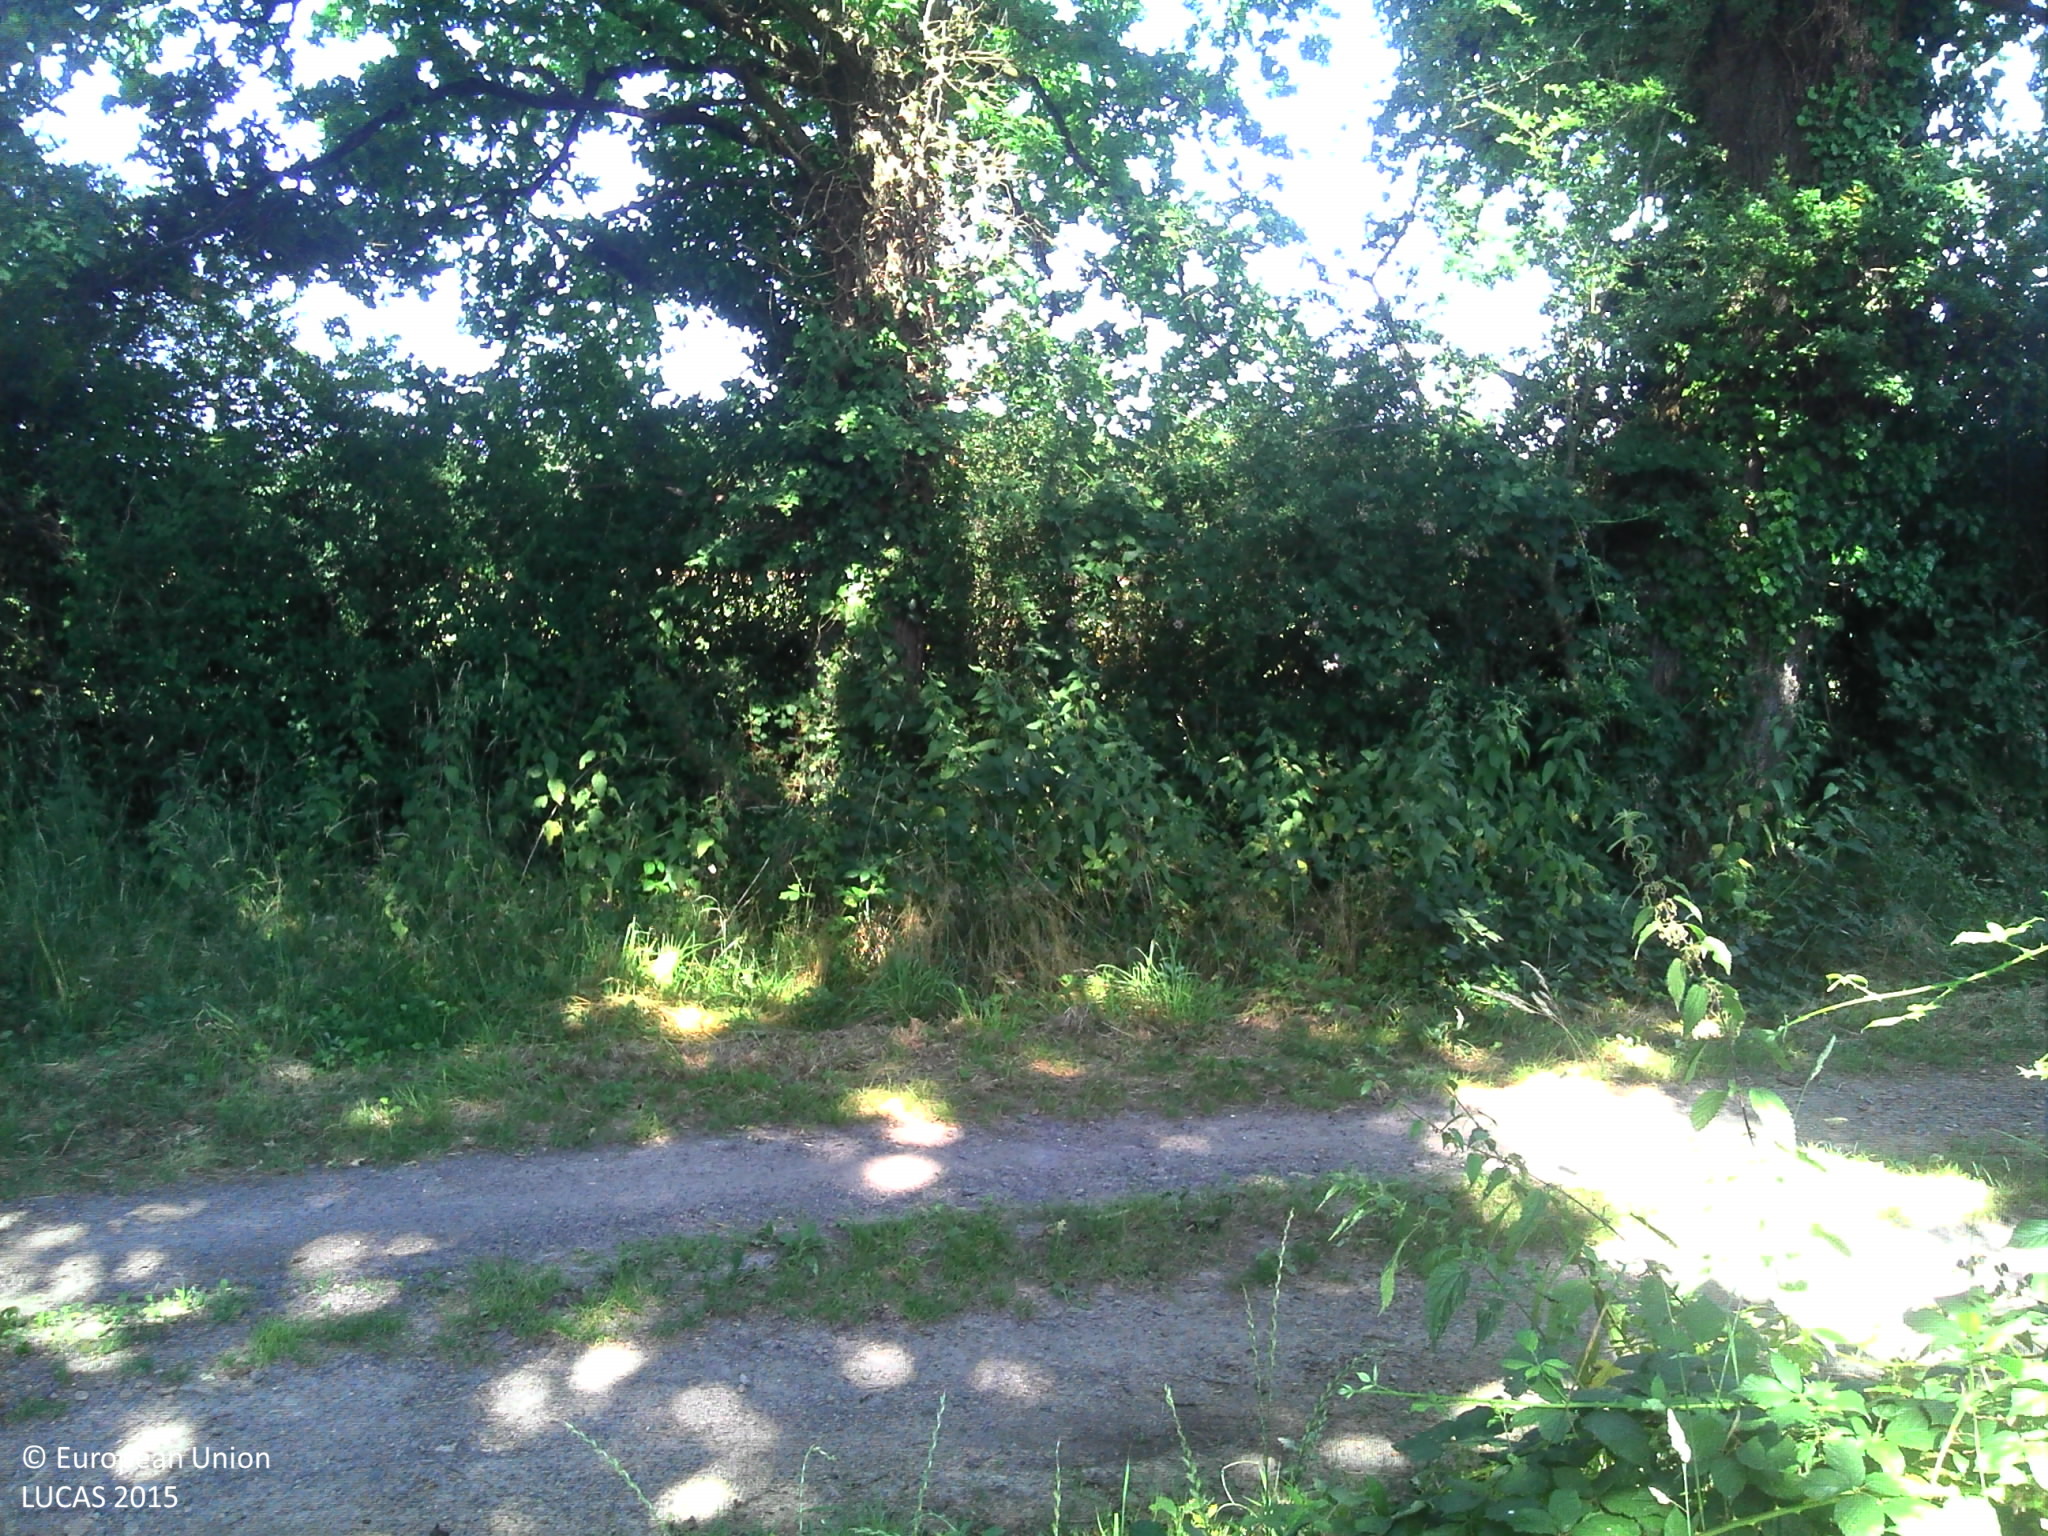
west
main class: Cropland
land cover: Oats
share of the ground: > 75 %
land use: Agriculture (excluding fallow land and kitchen gardens)
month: June
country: FR
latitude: 46.3435
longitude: 0.9042
